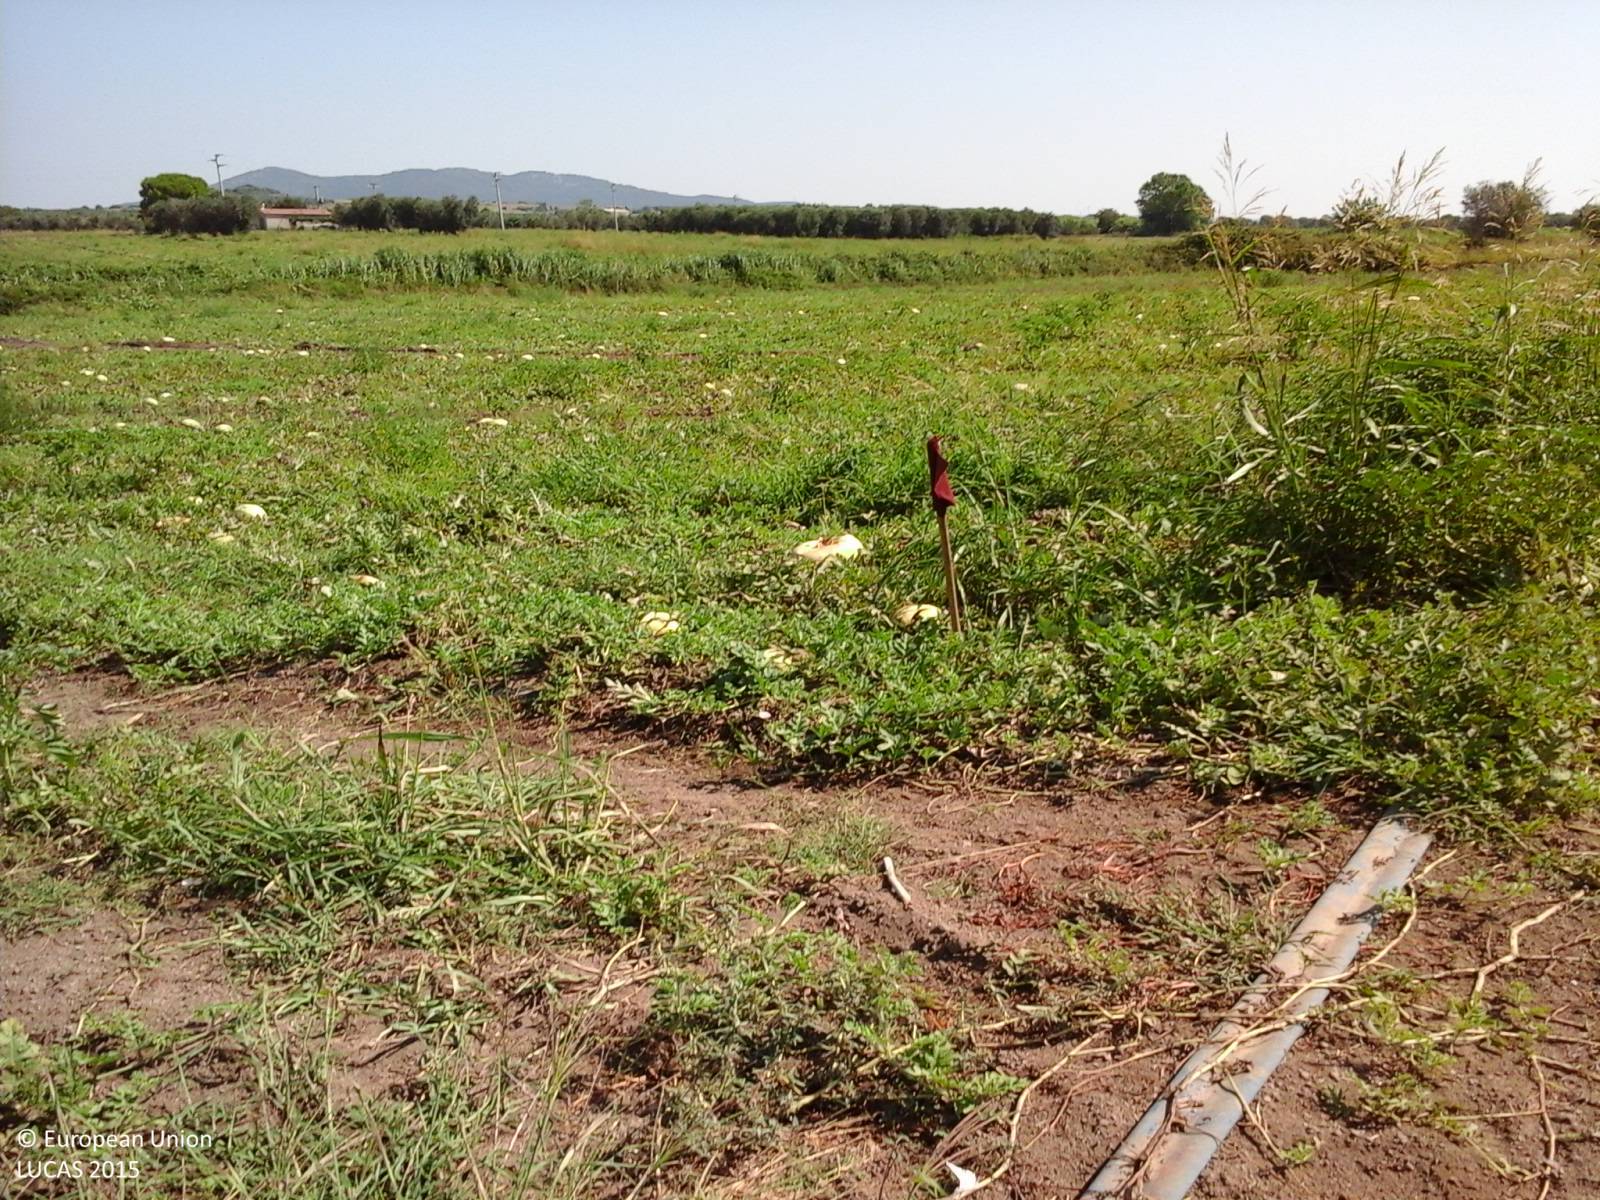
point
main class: Cropland
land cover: Other fresh vegetables
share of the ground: > 75 %
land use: Agriculture (excluding fallow land and kitchen gardens)
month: August
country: IT
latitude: 42.4056
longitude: 11.6588
